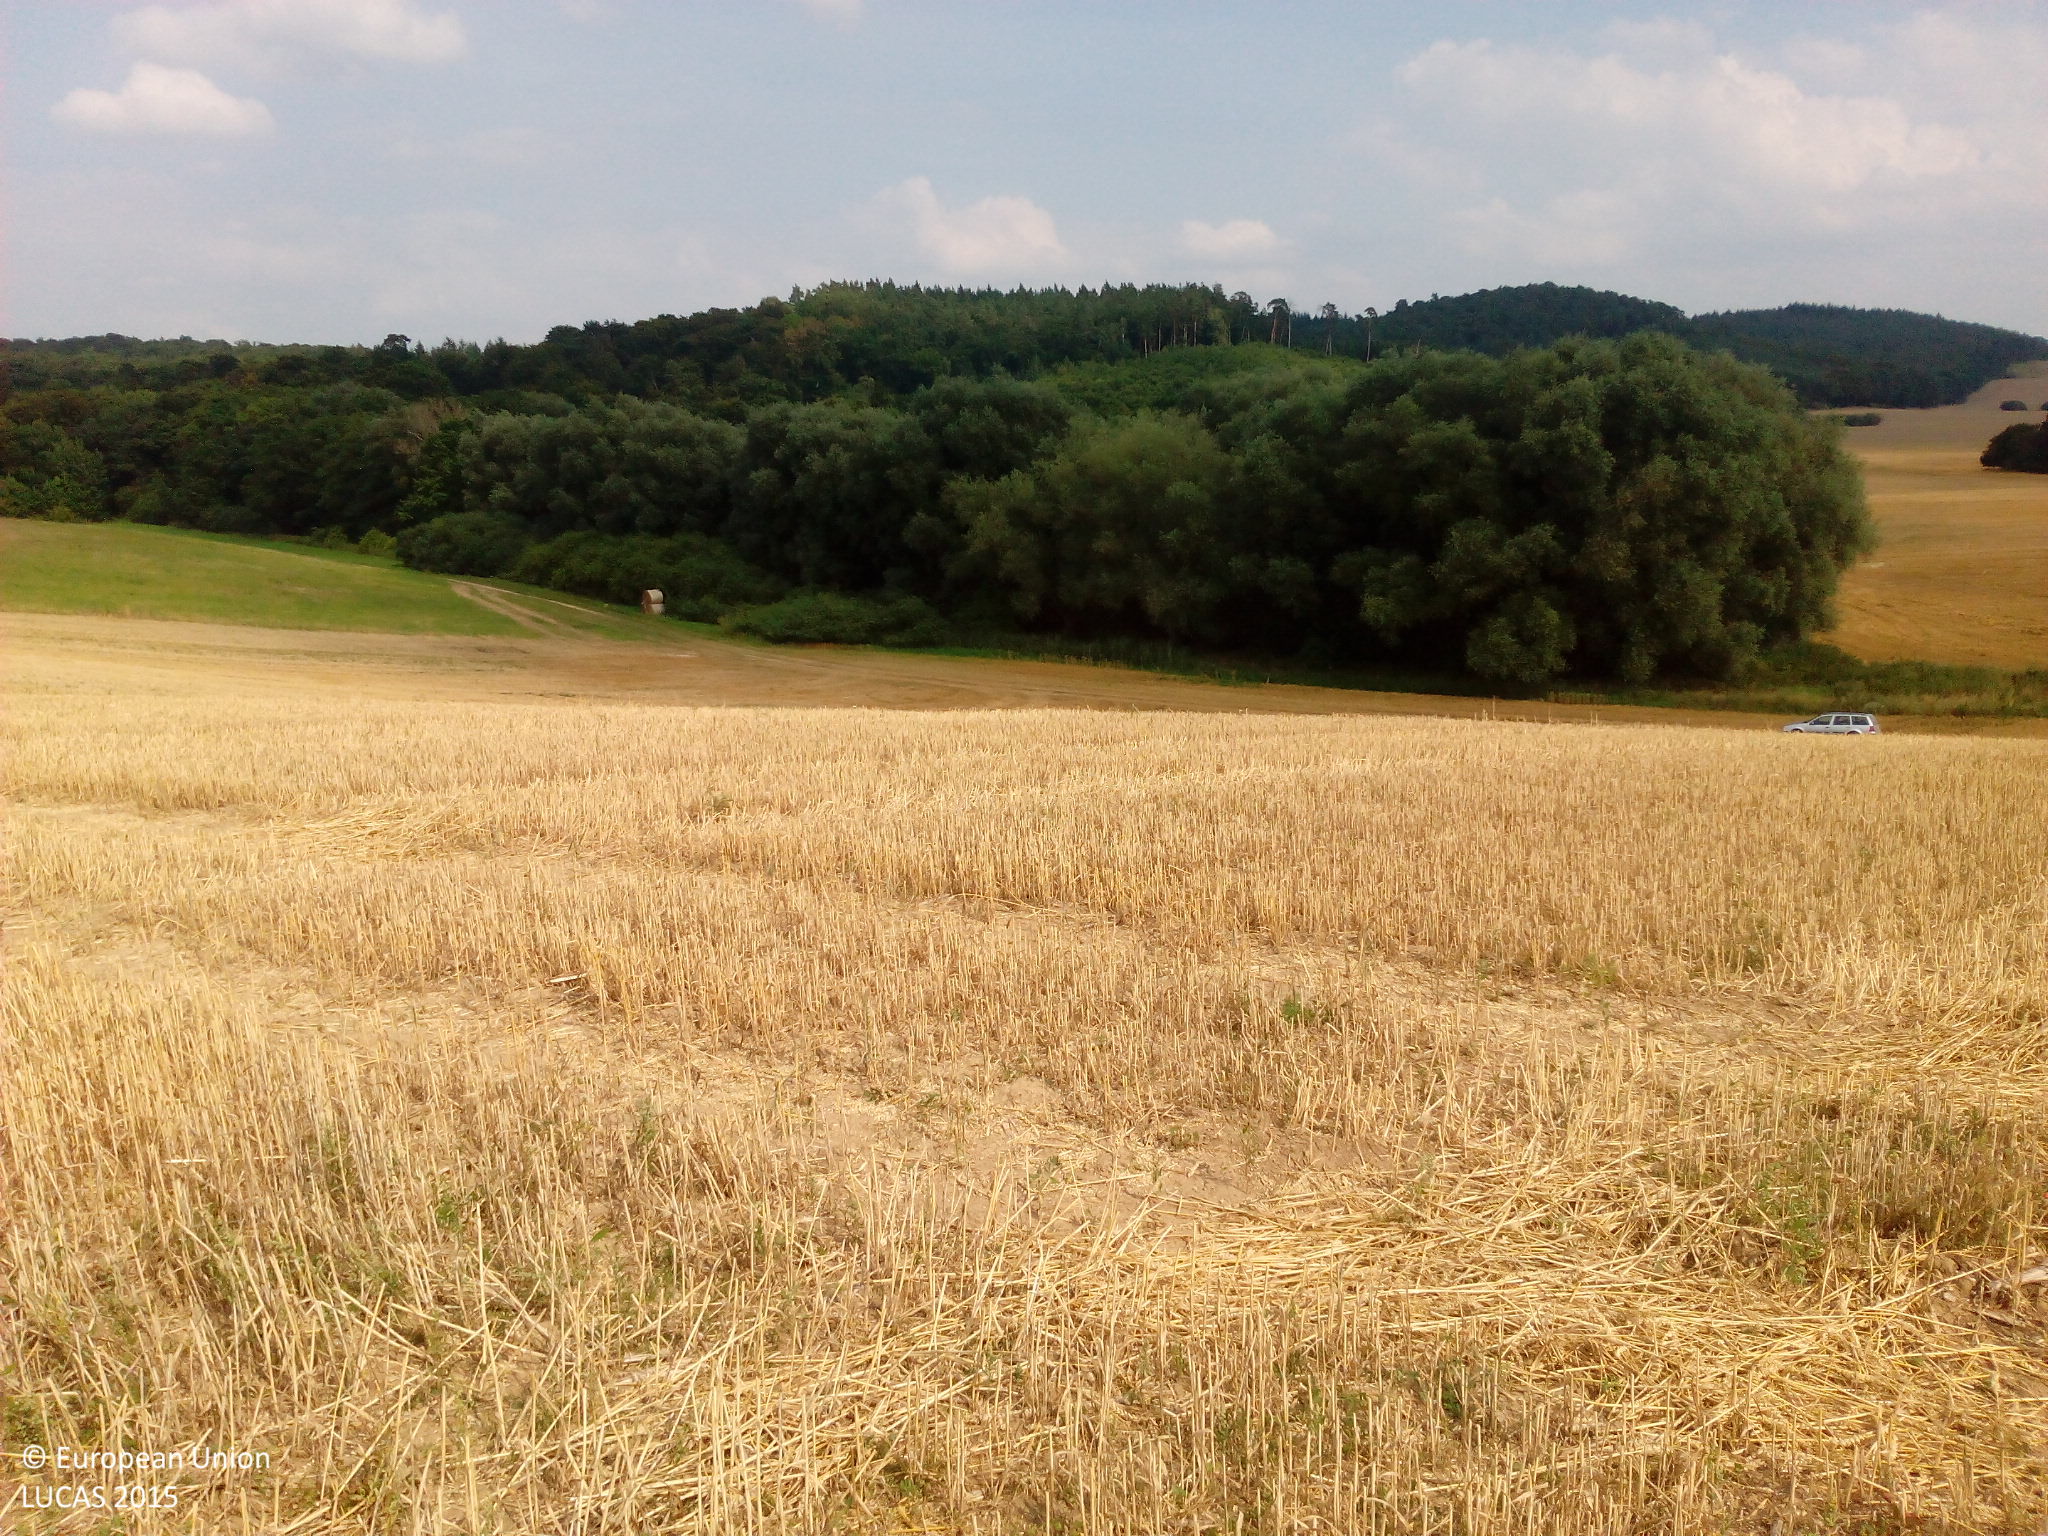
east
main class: Cropland
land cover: Common wheat
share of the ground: < 10 %
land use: Agriculture (excluding fallow land and kitchen gardens)
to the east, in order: Common wheat; Spontaneously vegetated surfaces; Tracks; Shruby margins; Broadleaved woodland; Inland marshes; Broadleaved woodland
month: August
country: DE
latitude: 53.7332
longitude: 12.6217
